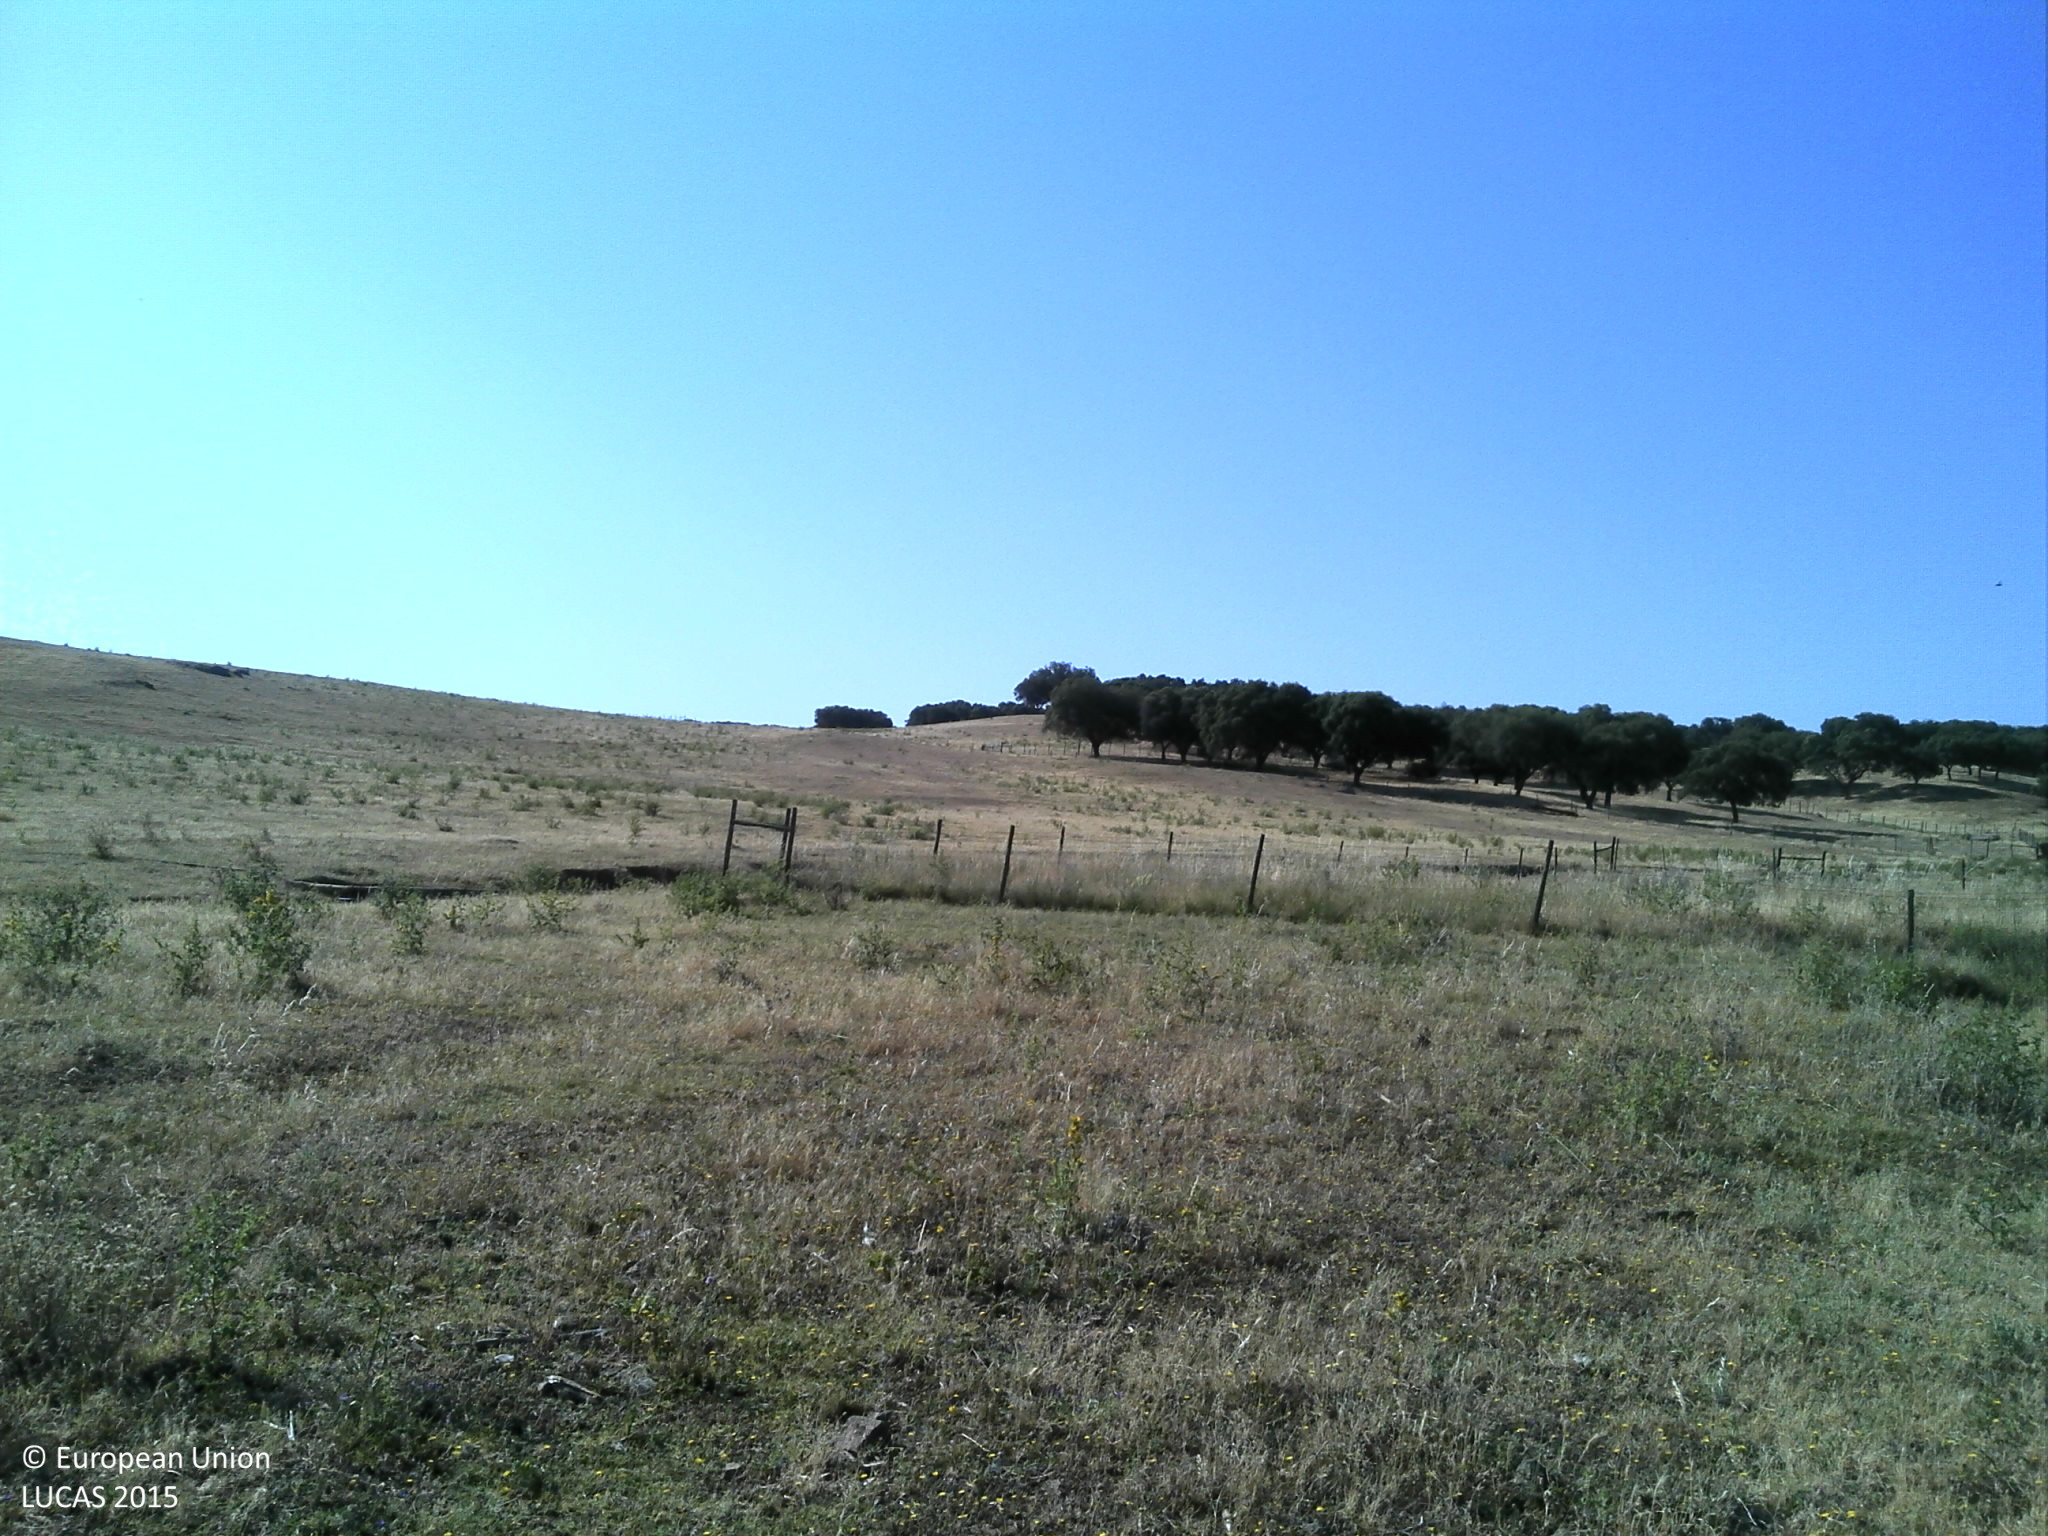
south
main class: Grassland
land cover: Grassland without tree/shrub cover
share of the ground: 25 - 50 %
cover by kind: herbaceous plants 45 %, unconsolidated bare surface 45 %
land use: Agriculture (excluding fallow land and kitchen gardens)
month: June
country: PT
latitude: 38.6514
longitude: -8.0501
